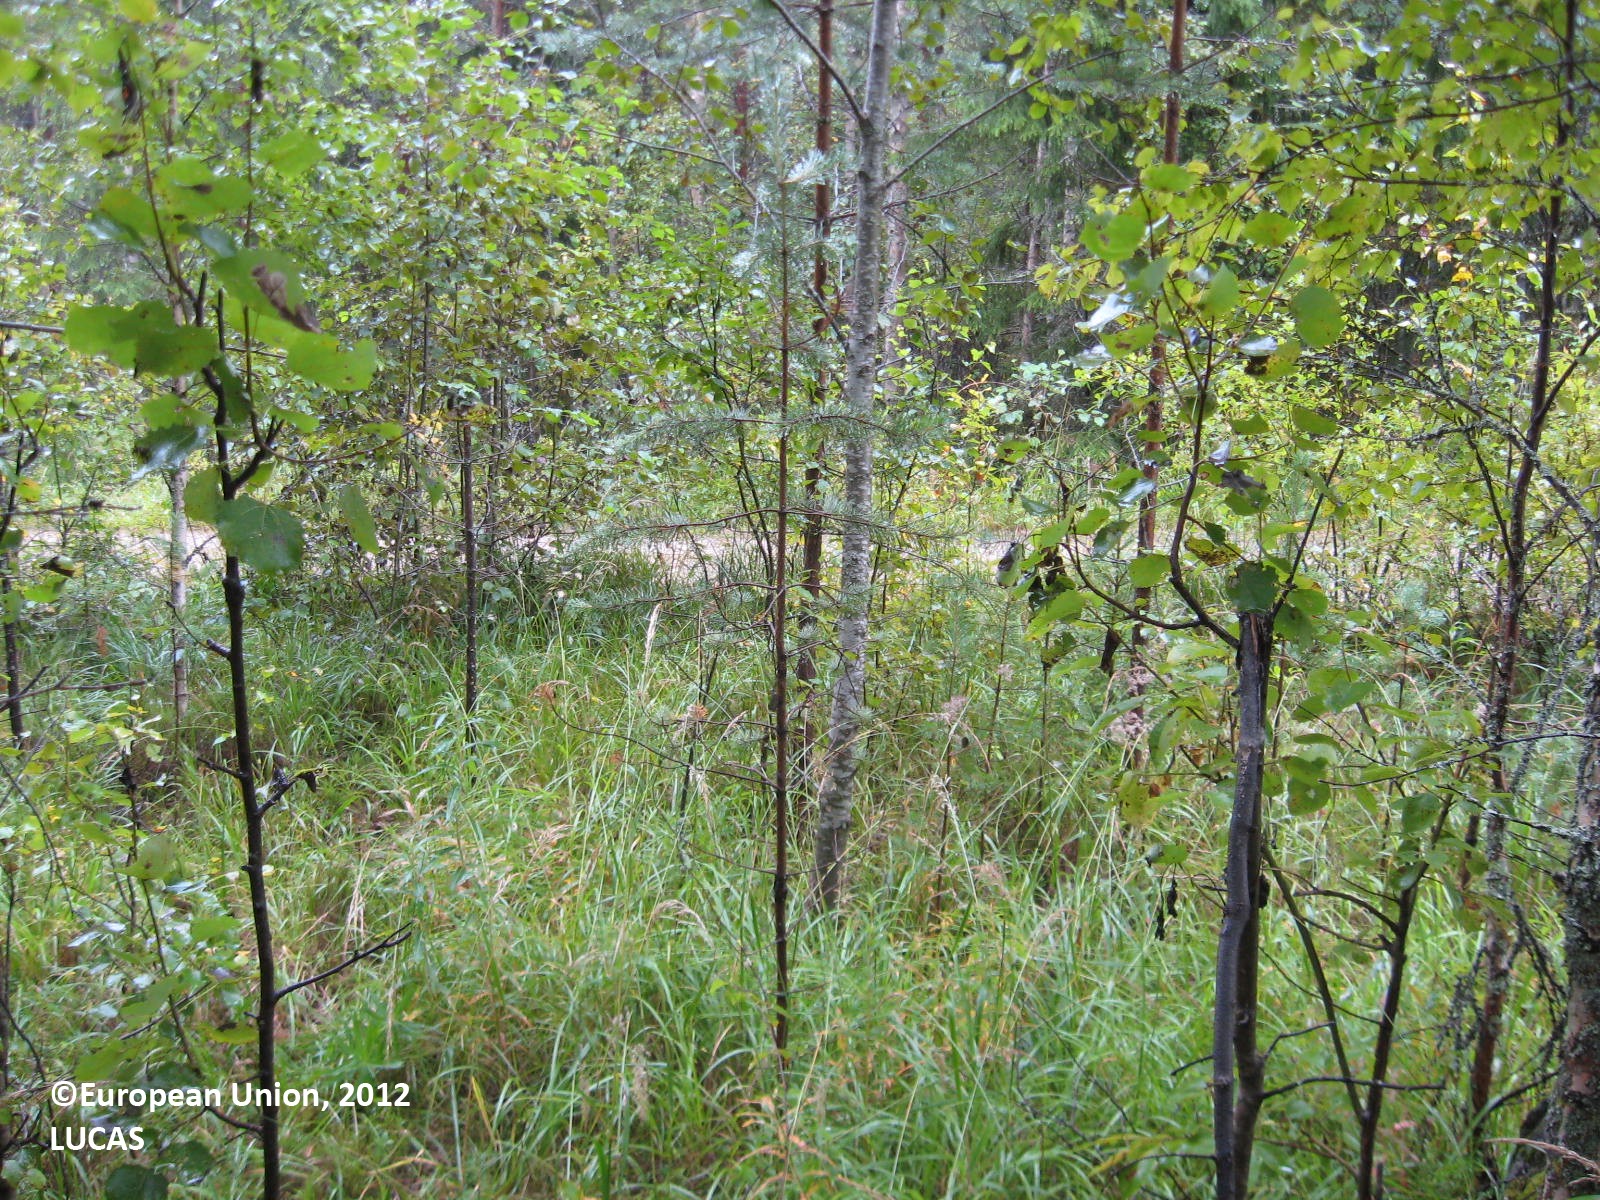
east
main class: Woodland
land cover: Pine dominated coniferous woodland
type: boreal forest
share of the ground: > 75 %
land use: Forestry
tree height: > 5 m
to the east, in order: Pine dominated coniferous woodland; Other mixed woodland; Paved roads, cycling and walking lanes; Shruby margins; Ditches and canals; Other mixed woodland; Ditches and canals; Abandoned hedges; Paved roads, cycling and walking lanes; Other mixed woodland
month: August
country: FI
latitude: 63.5671
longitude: 29.4534
